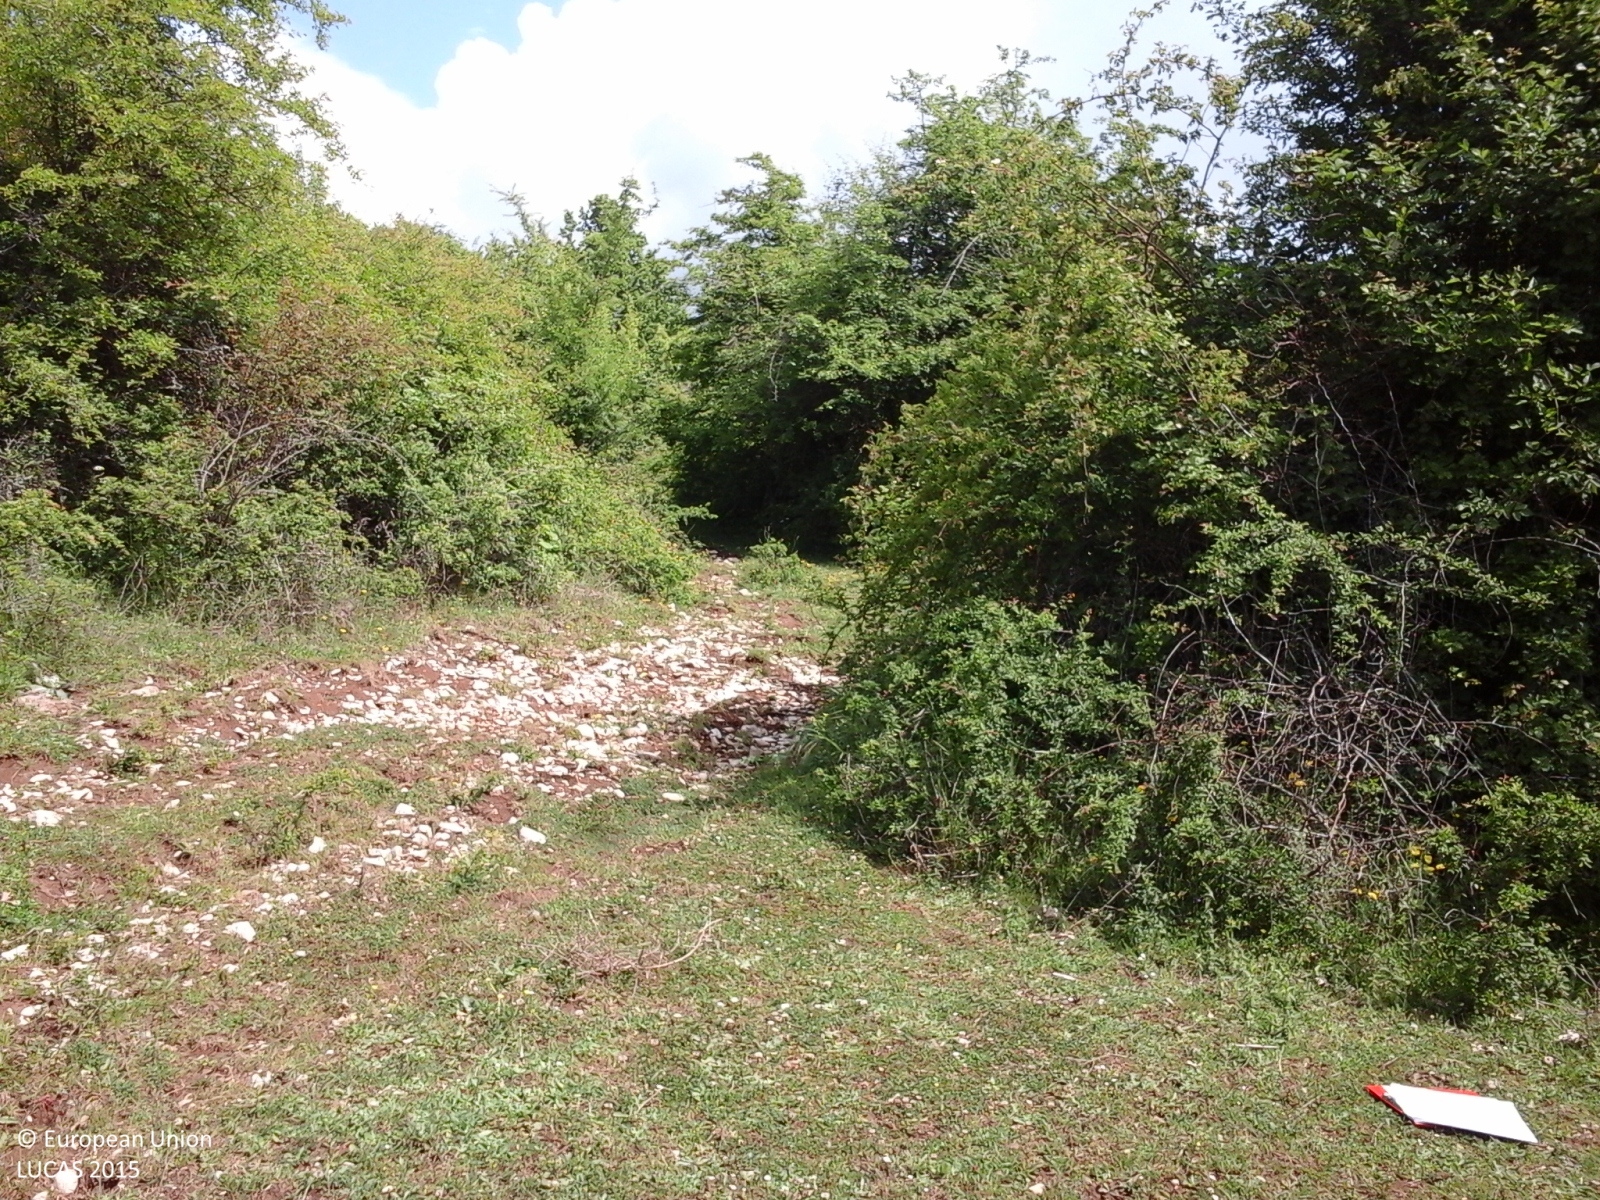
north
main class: Shrubland
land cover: Shrubland with sparse tree cover
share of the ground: 50 - 75 %
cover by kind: shrubs 90 %, broadleaved forest trees 5 %, herbaceous plants 5 %
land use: Forestry
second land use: Agriculture (excluding fallow land and kitchen gardens)
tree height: < 5 m
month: May
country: IT
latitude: 41.8628
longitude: 13.1809
